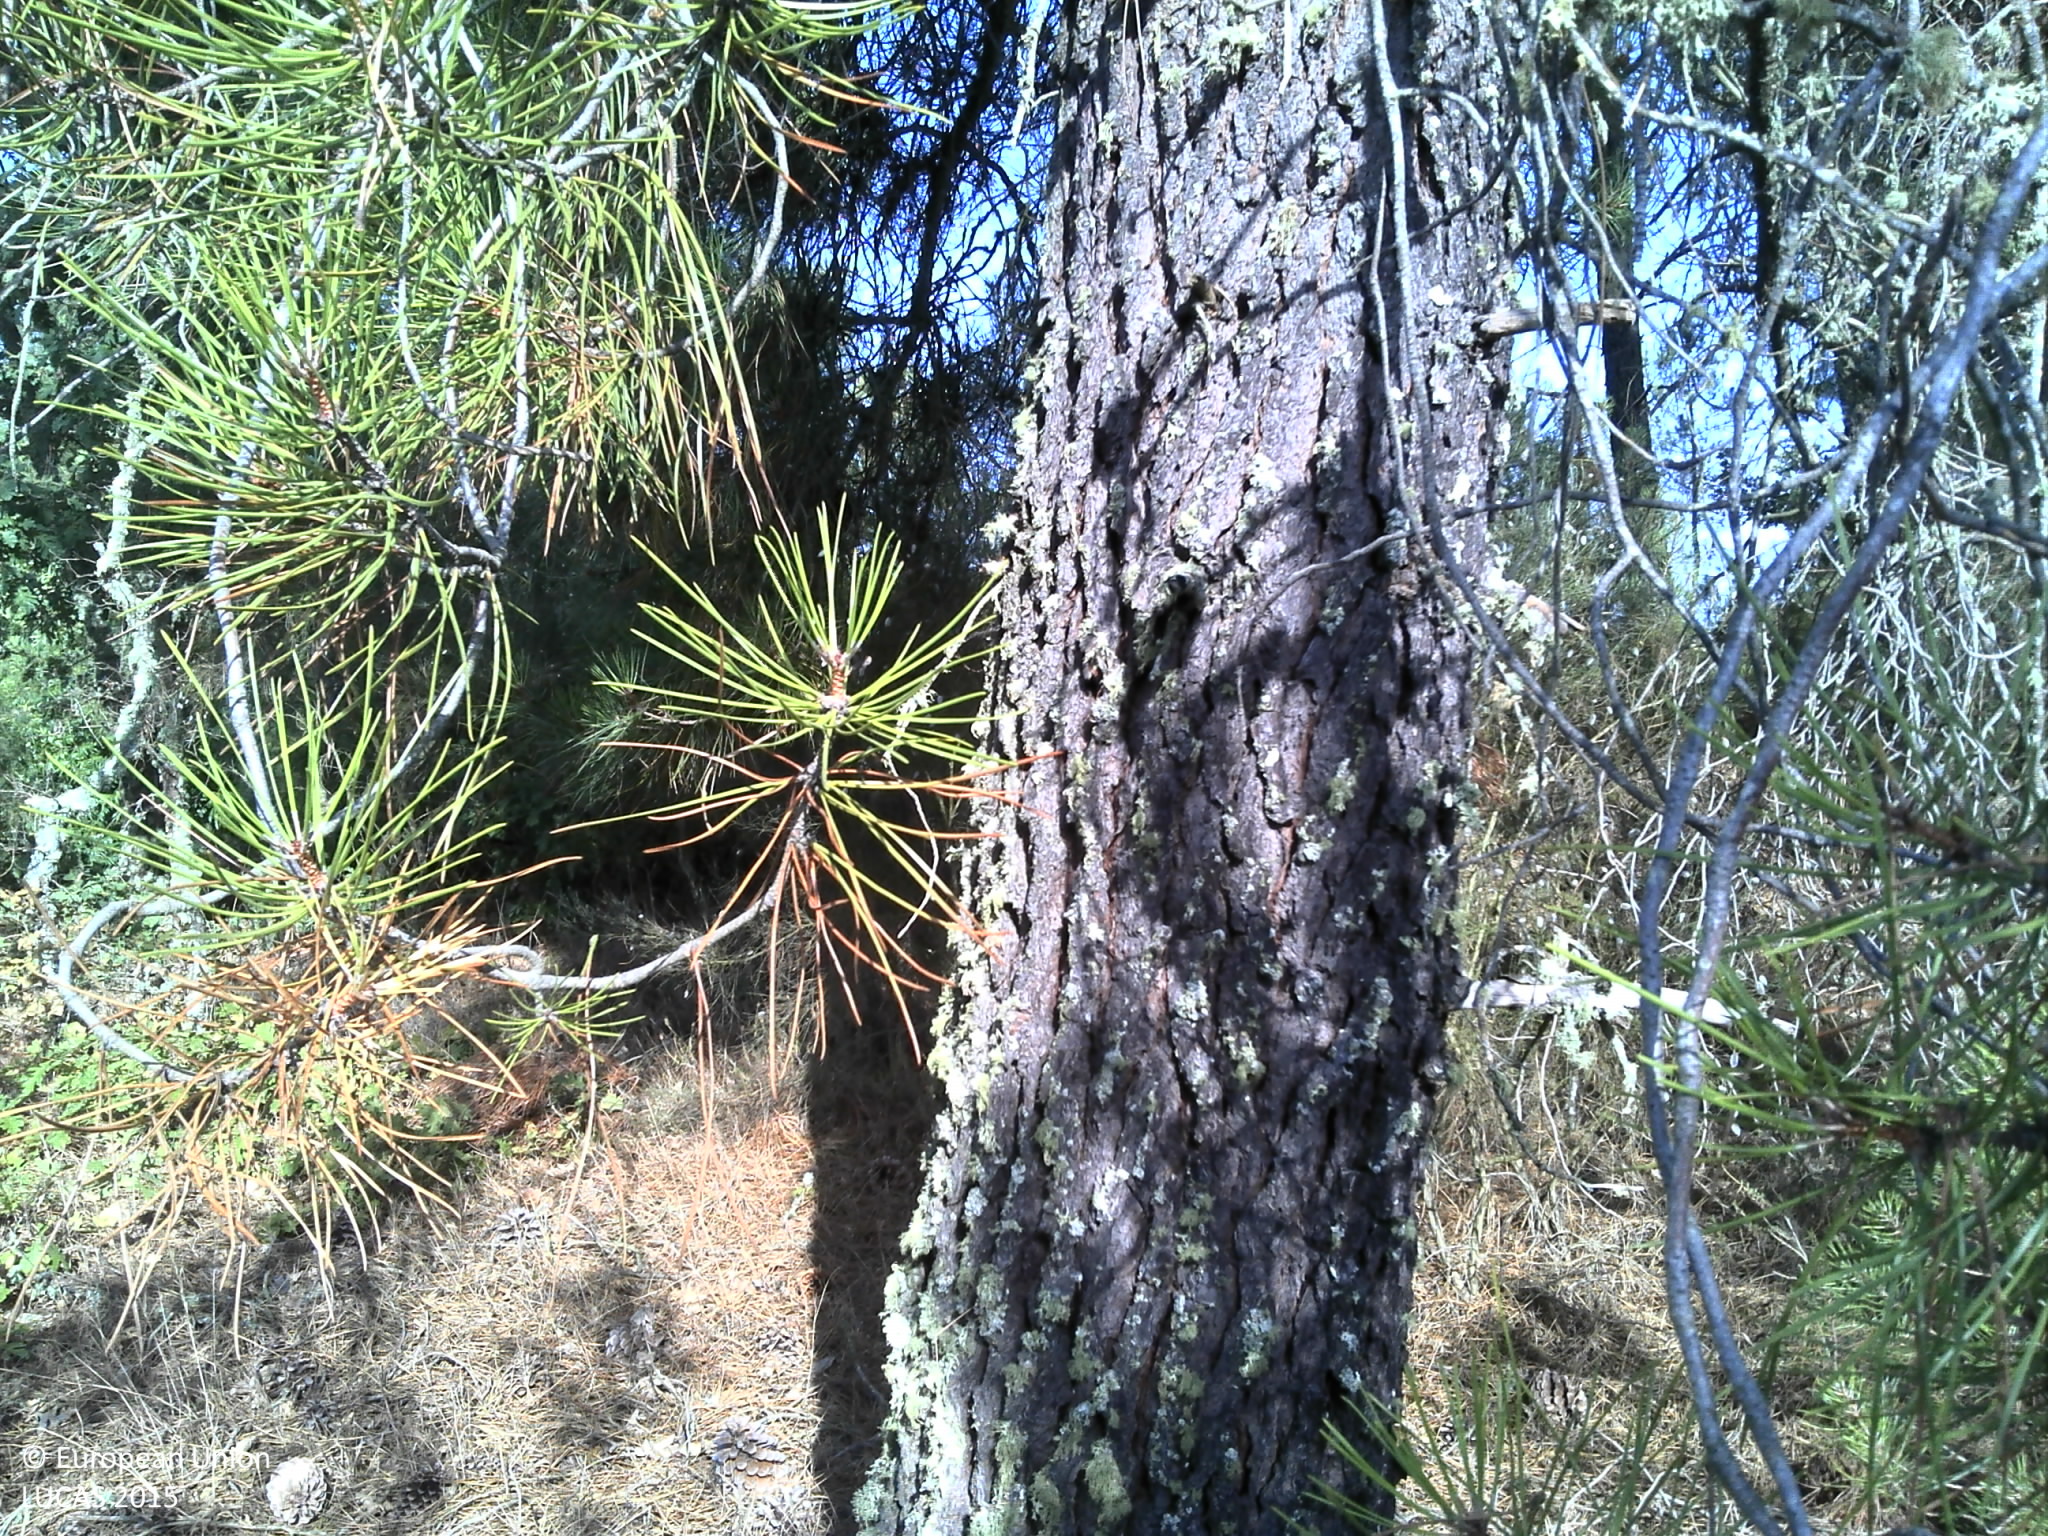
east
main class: Woodland
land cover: Pine dominated mixed woodland
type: coniferous forest of the mediterranean region
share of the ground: 25 - 50 %
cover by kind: coniferous forest trees 30 %, shrubs 30 %, unconsolidated bare surface 25 %, broadleaved forest trees 15 %
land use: Forestry
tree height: > 5 m
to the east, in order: Pine dominated mixed woodland; Dry stone walls; Tracks; Pine dominated coniferous woodland; Nuts trees; Dry stone walls; Nuts trees; Olive groves; Dry stone walls; Olive groves; Dry stone walls; Olive groves; Dry stone walls; Olive groves; Dry stone walls; Olive groves; Dry stone walls; Olive groves; Dry stone walls; Olive groves; Dry stone walls; Pine dominated coniferous woodland; Dry stone walls; Tracks; Dry stone walls; Olive groves; Dry stone walls; Olive groves
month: July
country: PT
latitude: 40.9507
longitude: -7.4984
